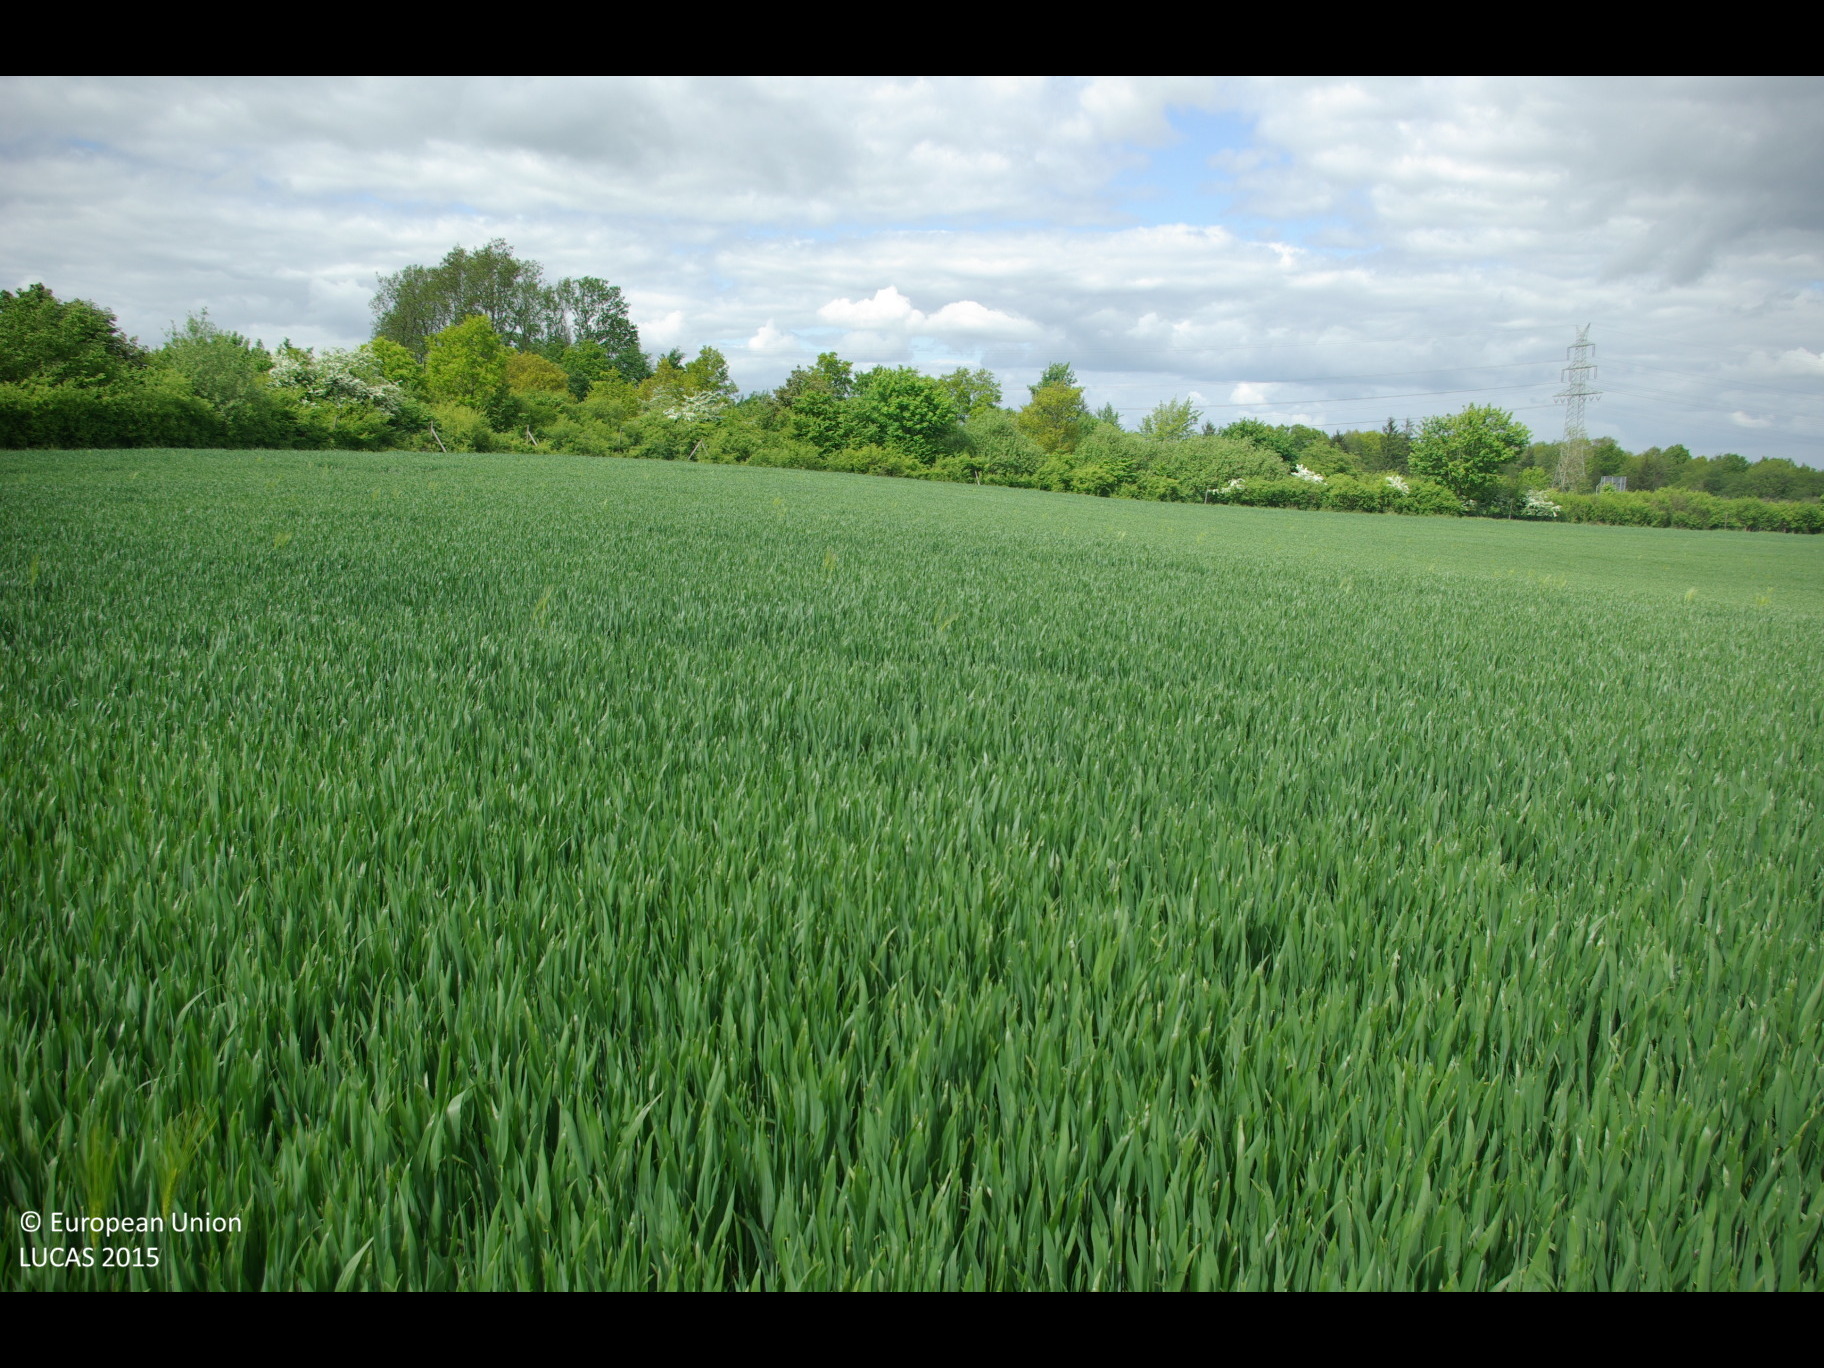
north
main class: Cropland
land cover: Common wheat
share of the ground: > 75 %
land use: Agriculture (excluding fallow land and kitchen gardens)
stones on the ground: < 10 %
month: May
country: DE
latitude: 54.3185
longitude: 9.9539
